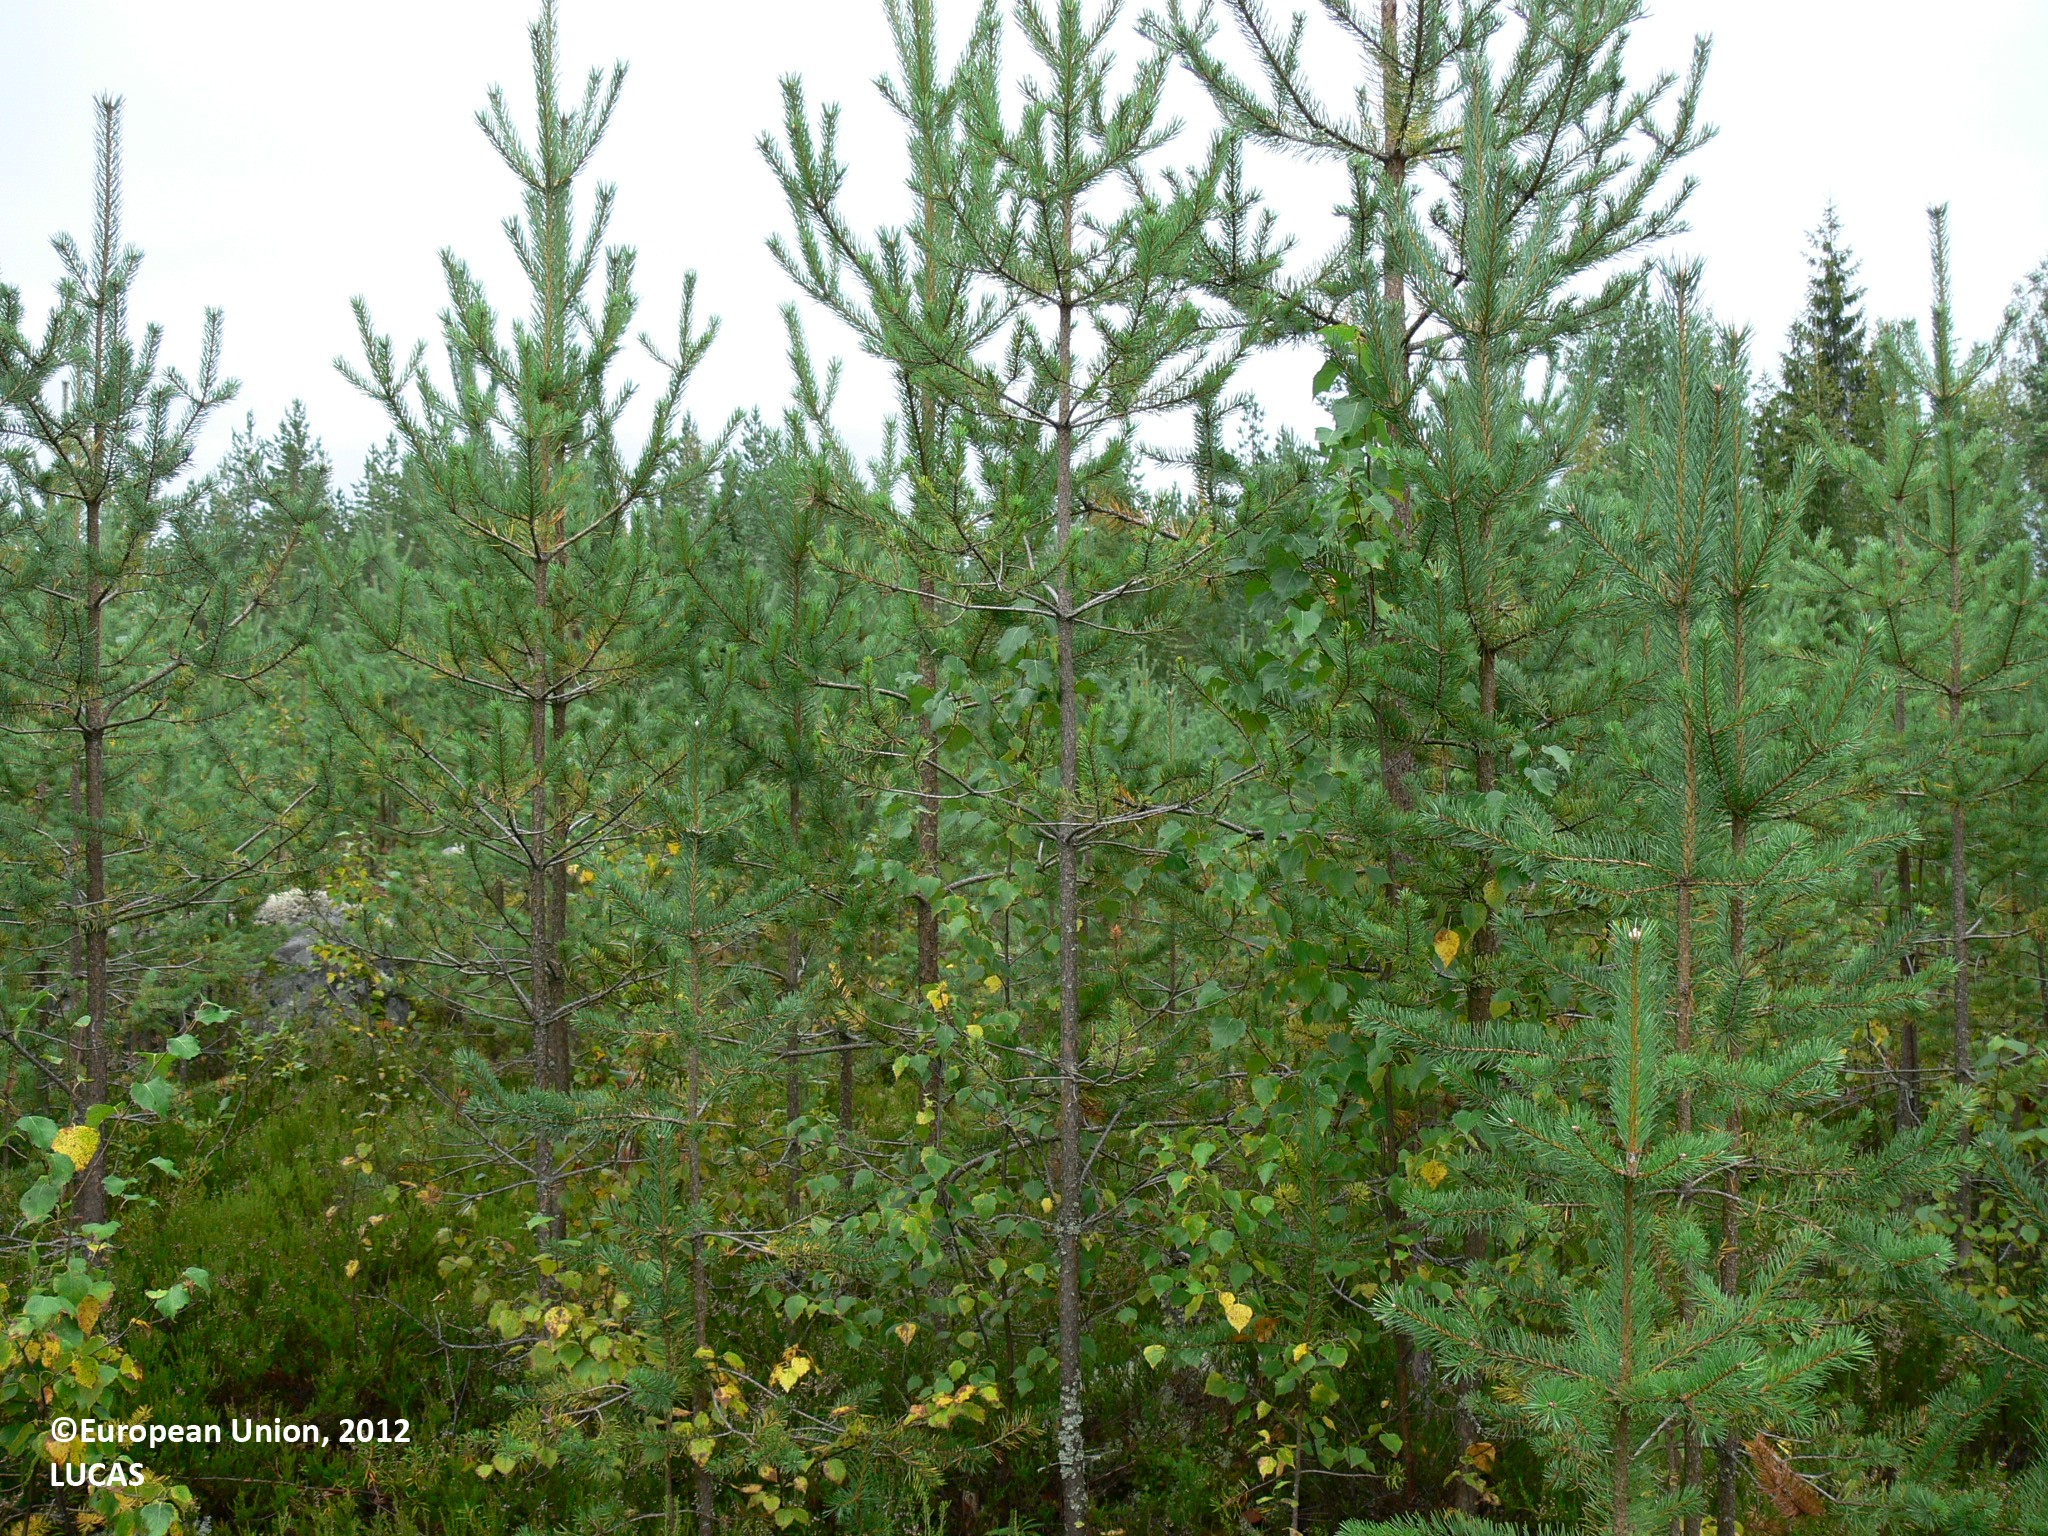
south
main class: Woodland
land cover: Pine dominated mixed woodland
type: boreal forest
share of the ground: 25 - 50 %
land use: Forestry
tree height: < 5 m
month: August
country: FI
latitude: 63.1712
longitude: 30.1795
